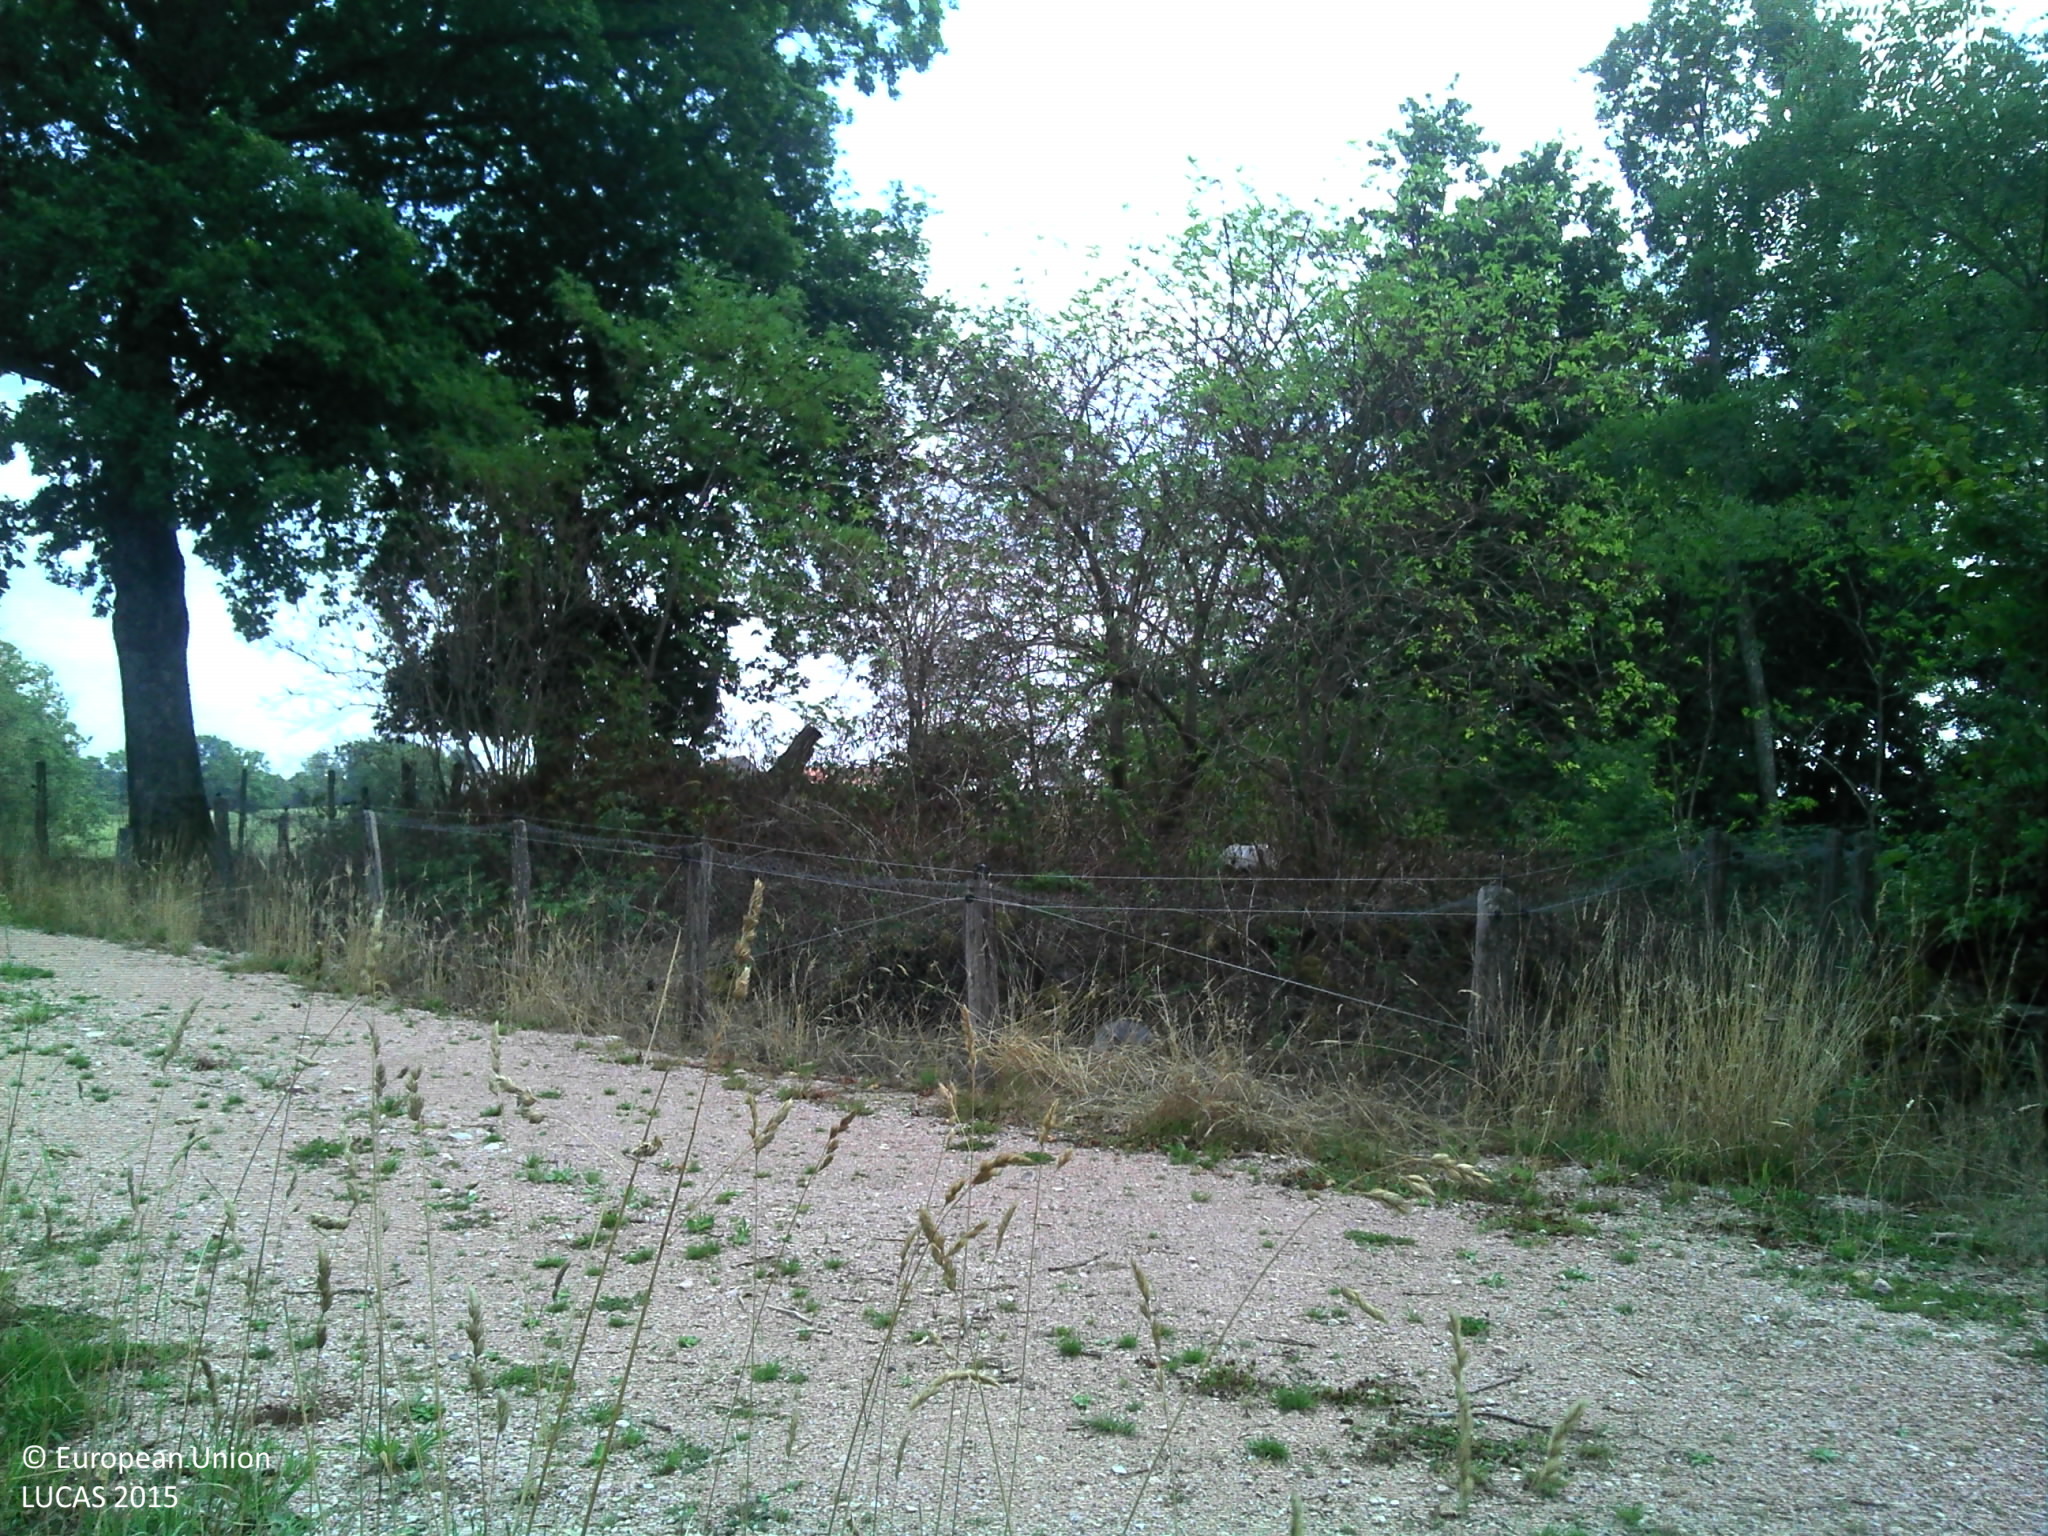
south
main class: Grassland
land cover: Grassland without tree/shrub cover
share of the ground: > 75 %
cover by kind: herbaceous plants 100 %
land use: Agriculture (excluding fallow land and kitchen gardens)
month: August
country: FR
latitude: 46.3445
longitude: 3.6721
